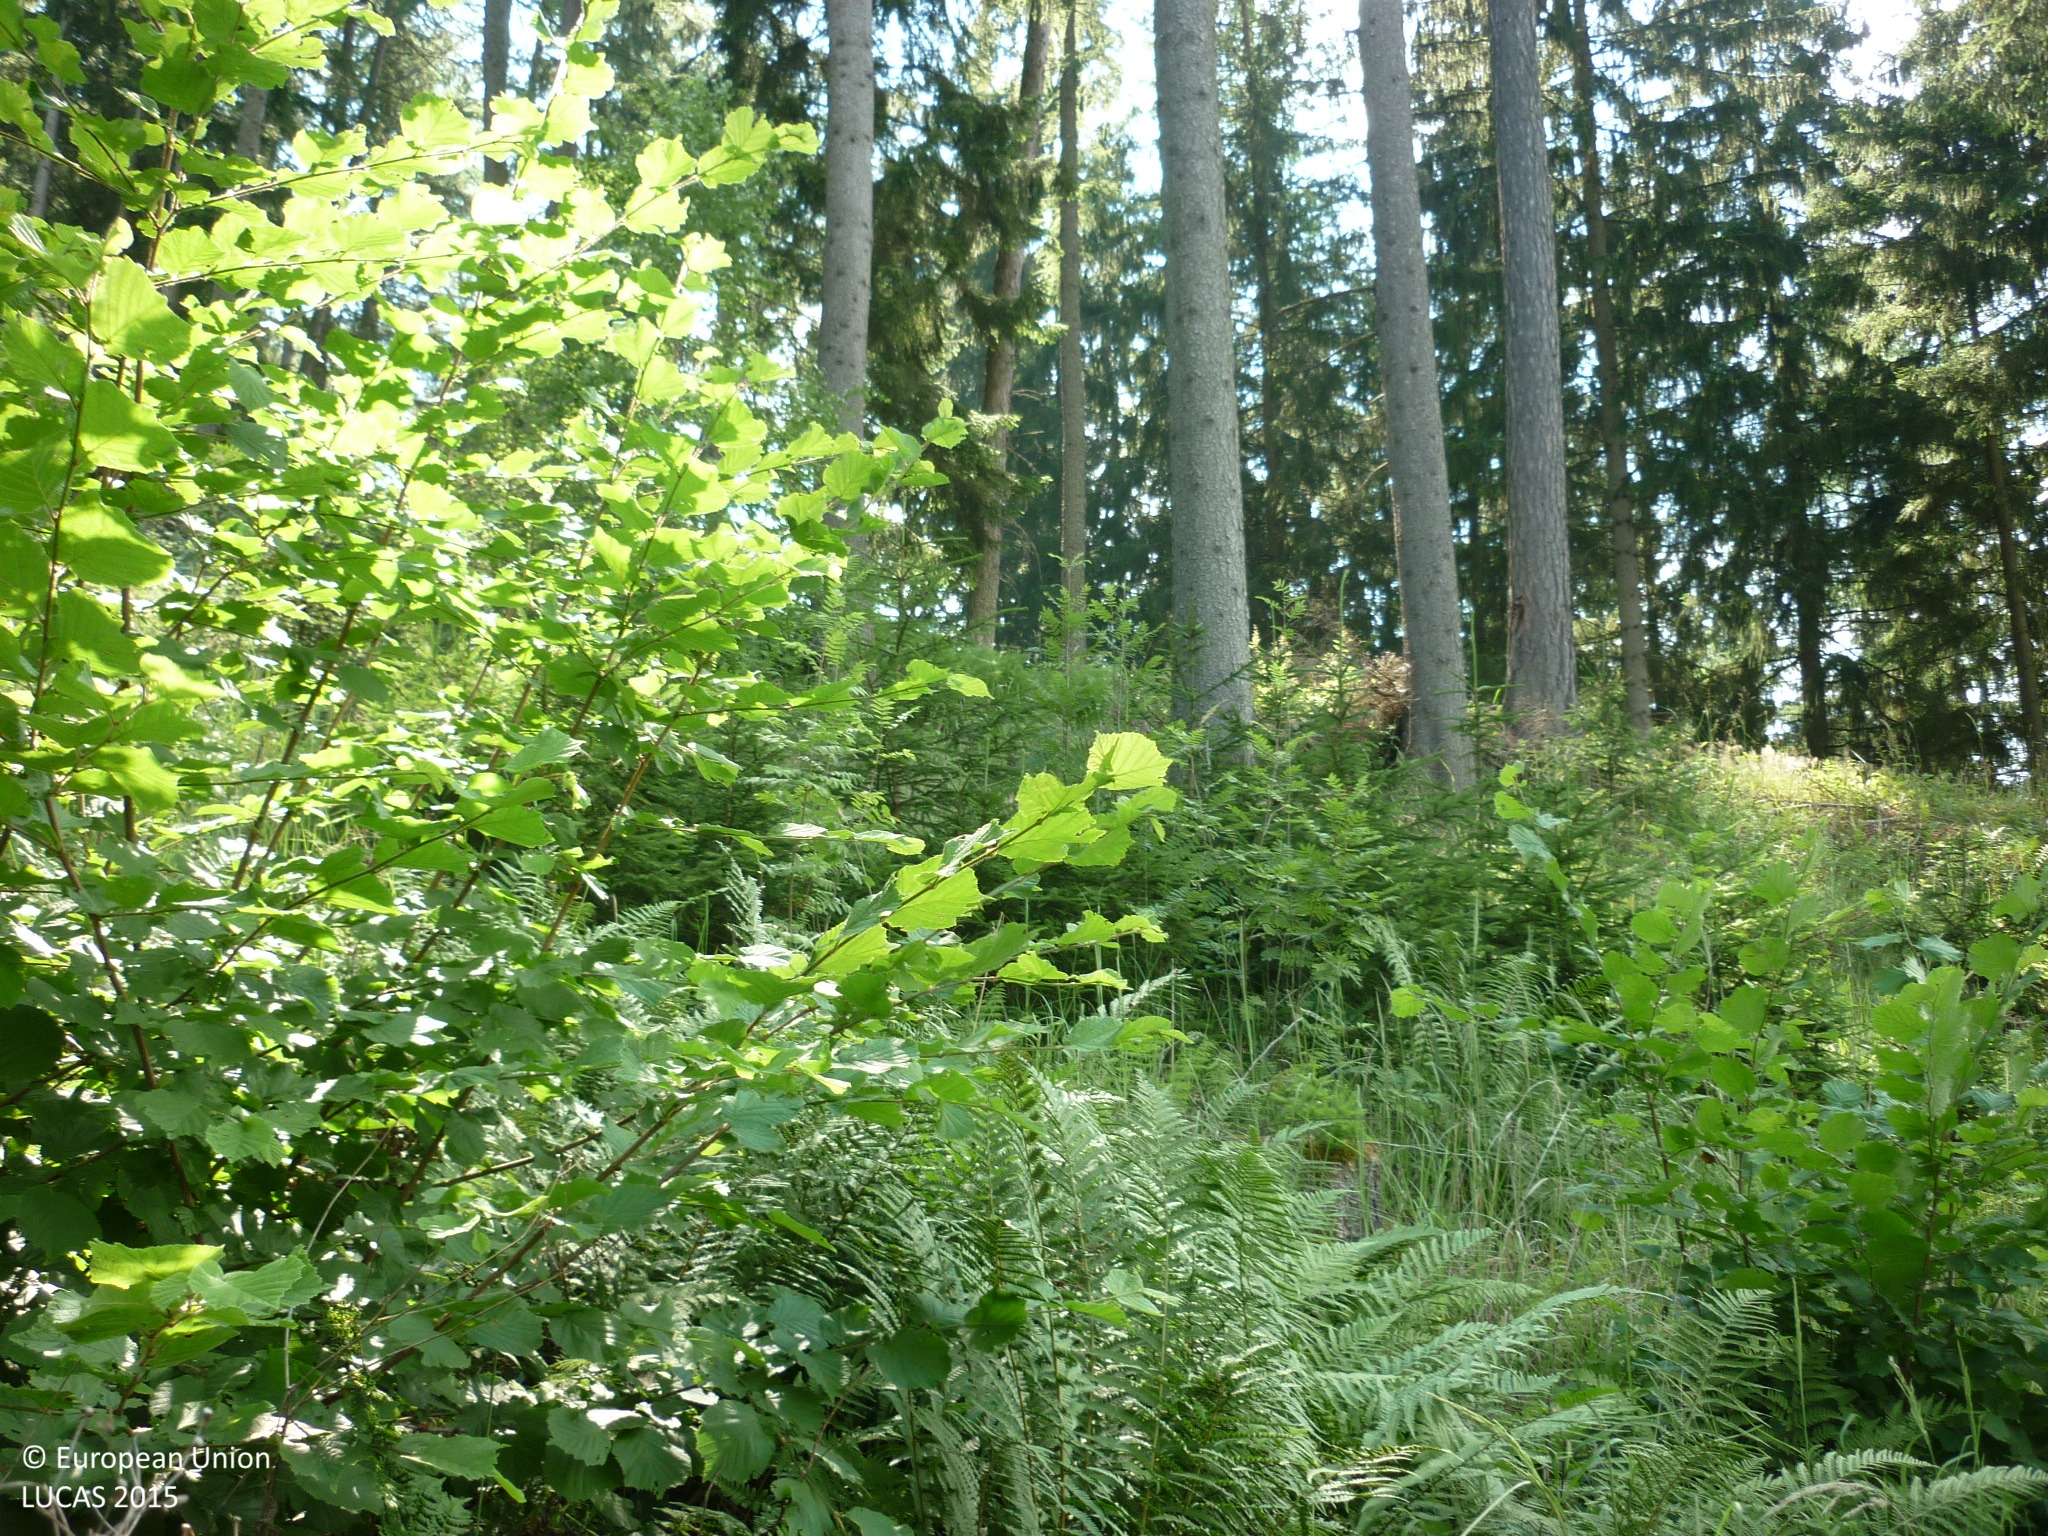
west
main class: Woodland
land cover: Spruce dominated coniferous woodland
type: alpine coniferous forest
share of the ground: 50 - 75 %
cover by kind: coniferous forest trees 40 %, herbaceous plants 30 %, shrubs 20 %, broadleaved forest trees 10 %
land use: Forestry
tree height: > 5 m
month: July
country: AT
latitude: 47.1964
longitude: 14.8697
